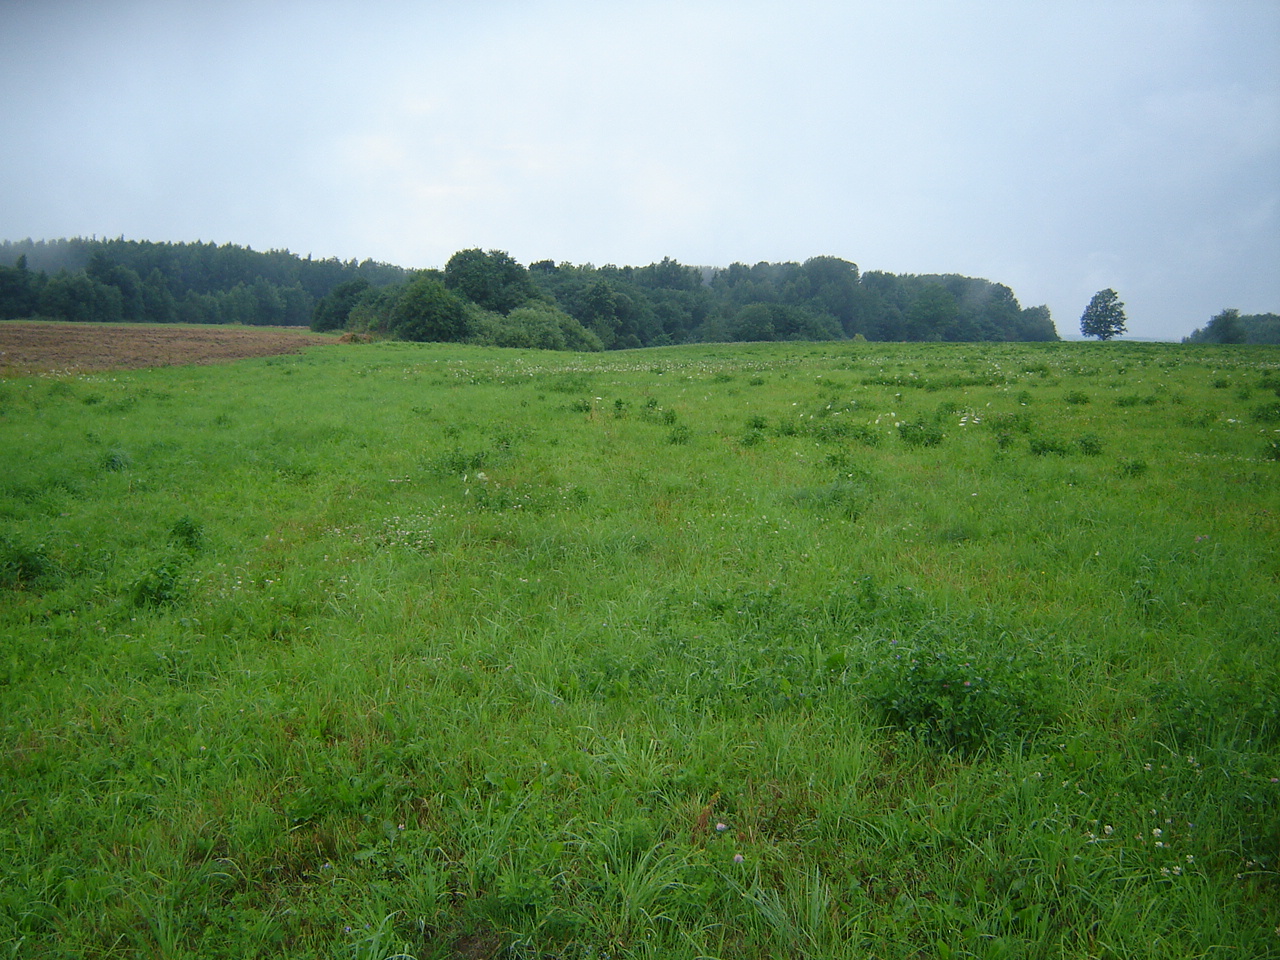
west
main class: Grassland
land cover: Grassland without tree/shrub cover
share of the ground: > 75 %
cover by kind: herbaceous plants 100 %
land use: Agriculture (excluding fallow land and kitchen gardens)
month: July
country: LT
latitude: 55.4355
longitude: 25.0812
